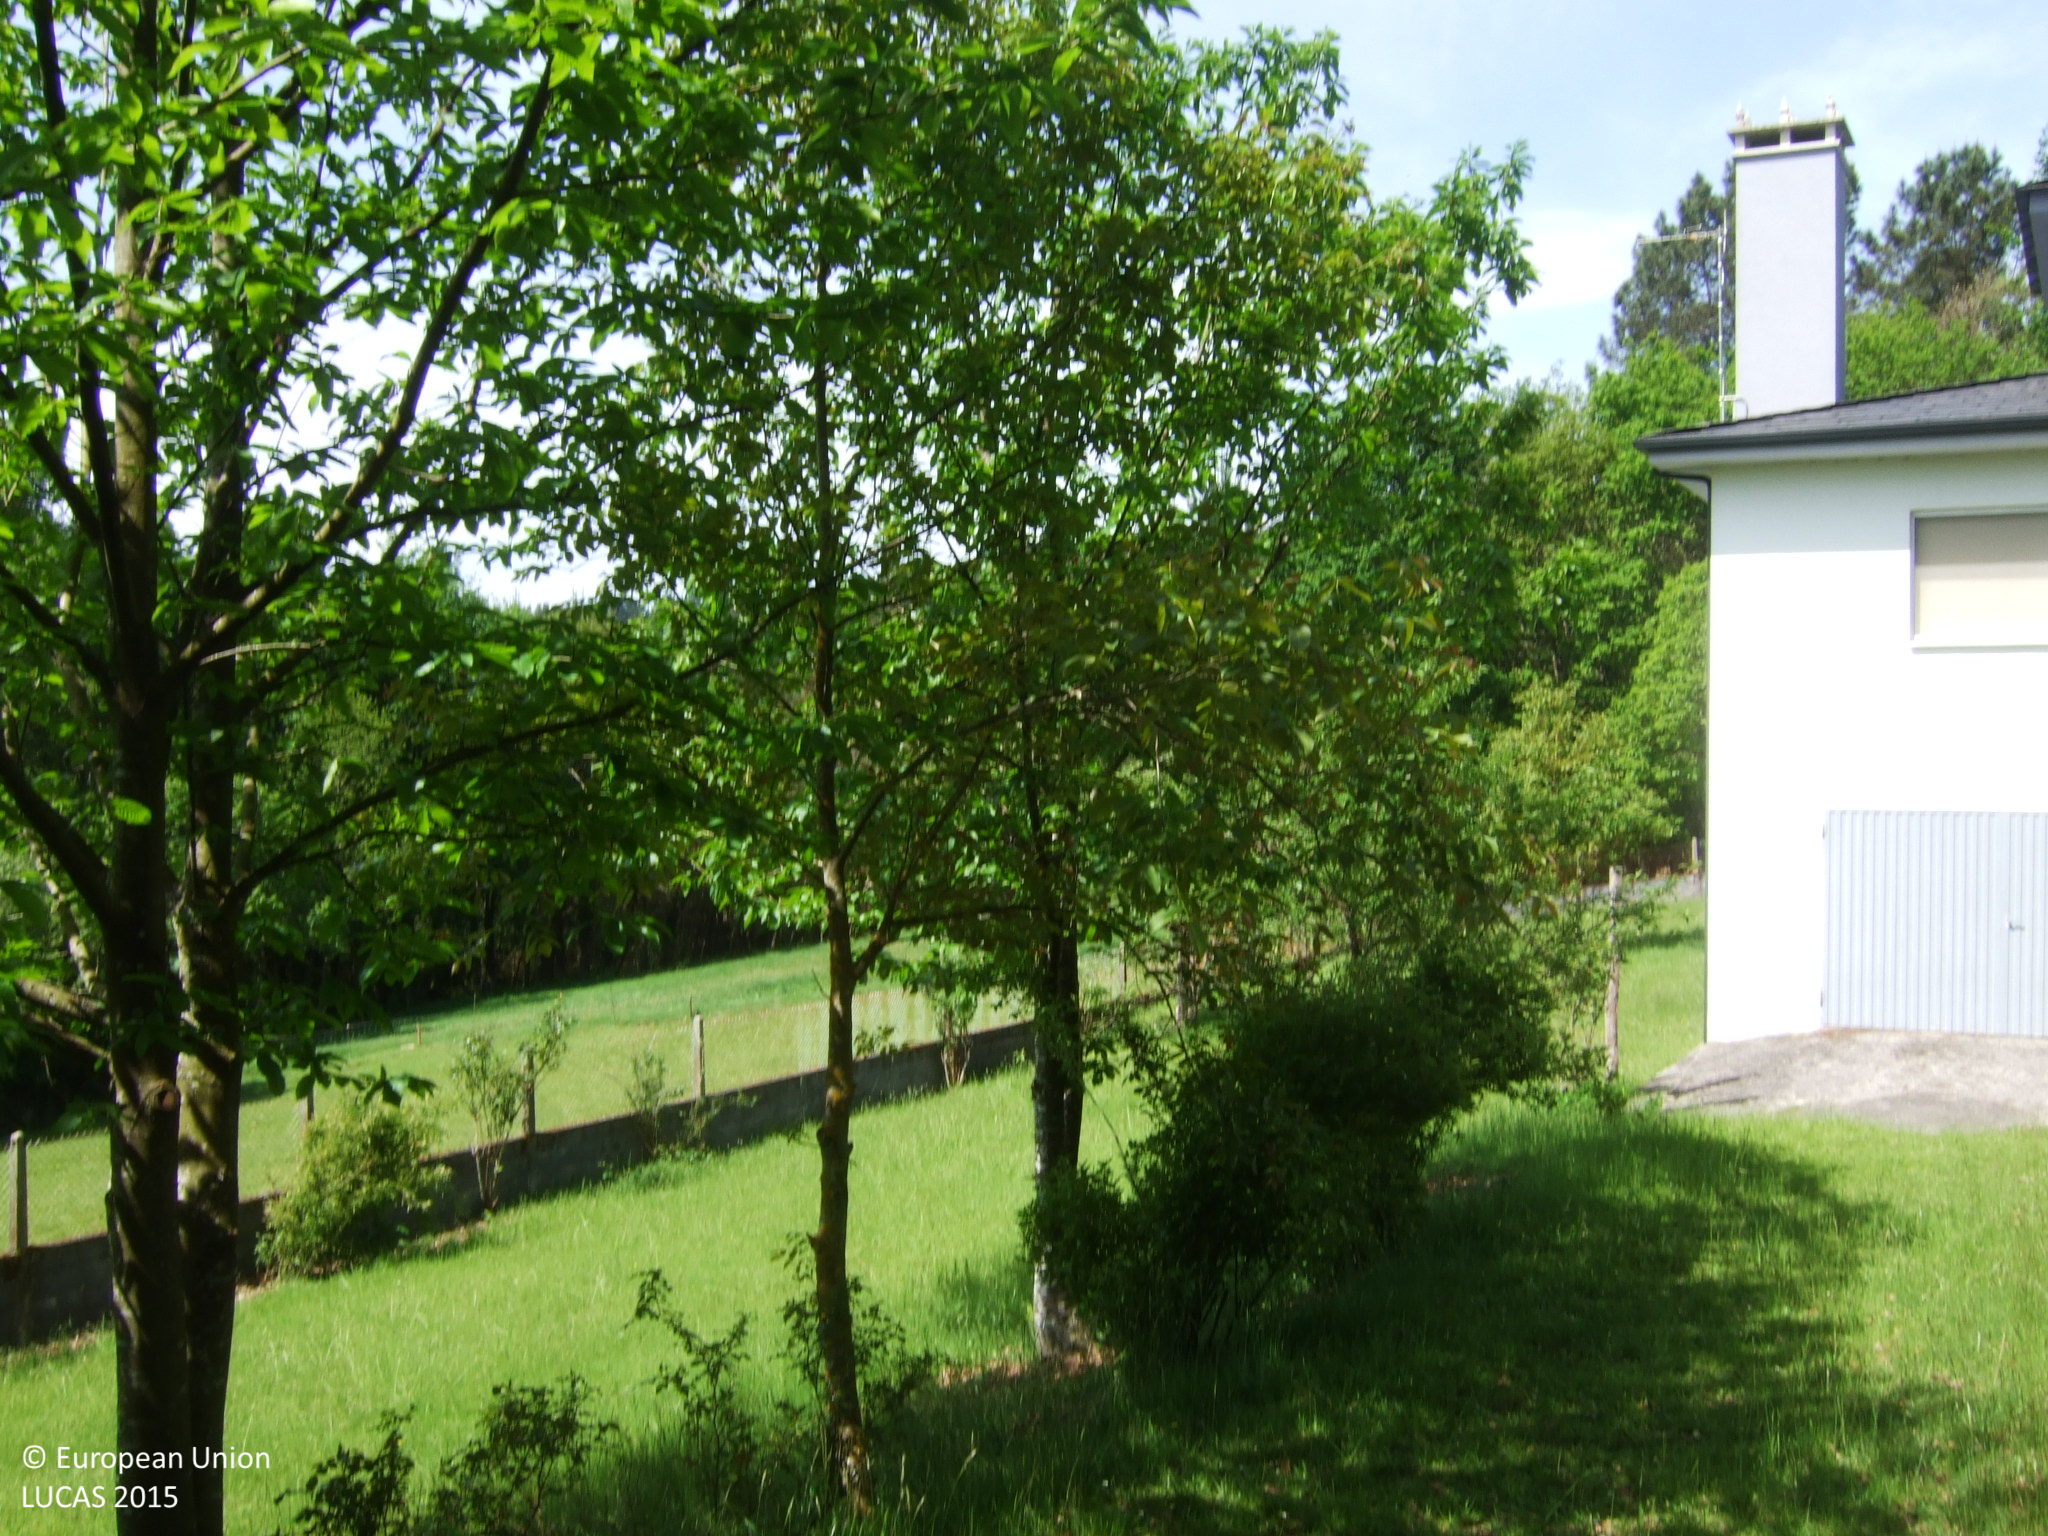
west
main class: Cropland
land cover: Apple fruit
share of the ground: 10 - 25 %
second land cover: Grassland without tree/shrub cover
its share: > 75 %
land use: Kitchen garden
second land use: Residential
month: May
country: ES
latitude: 42.9639
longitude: -7.3697
